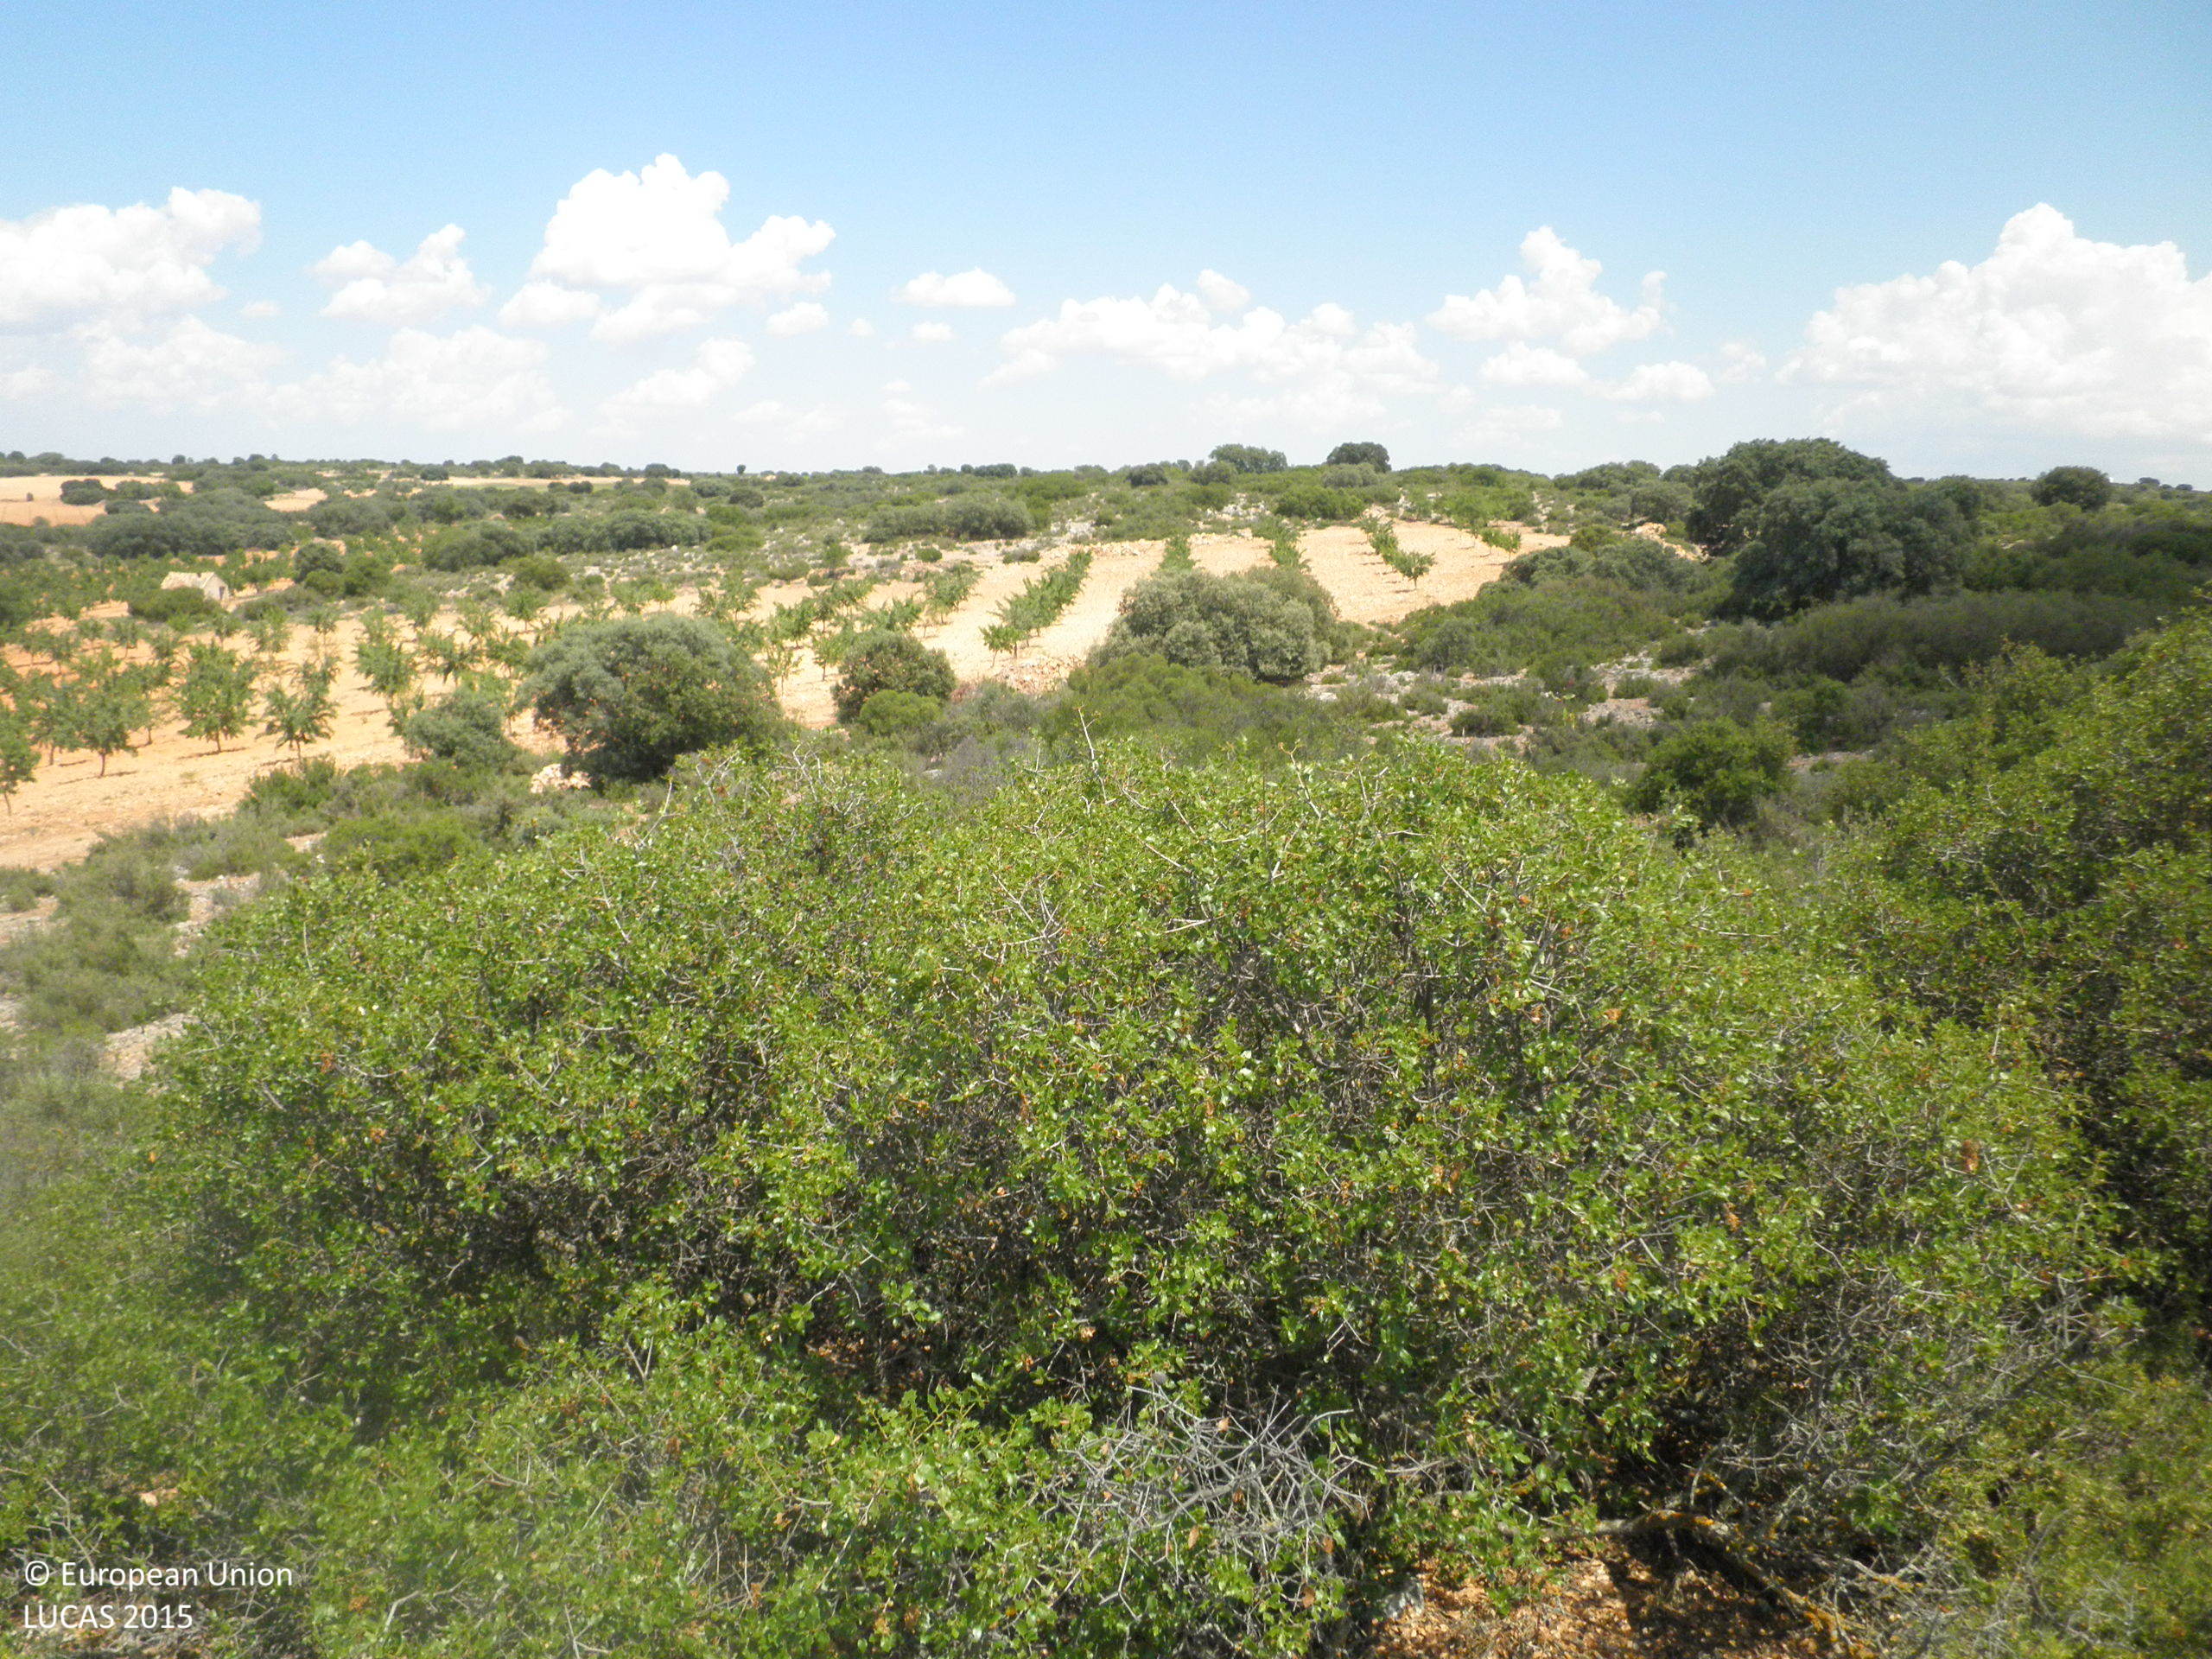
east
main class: Shrubland
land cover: Shrubland without tree cover
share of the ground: 25 - 50 %
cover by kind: consolidated bare surface 50 %, shrubs 40 %, unconsolidated bare surface 10 %
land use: Semi-natural and natural areas not in use
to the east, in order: Shrubland without tree cover; Dry stone walls; Grass margins; Tracks; Grass margins; Nuts trees; Dry stone walls; Grass margins; Tracks; Shrubland with sparse tree cover; Shrubland without tree cover; Broadleaved woodland
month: June
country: ES
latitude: 39.4844
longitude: -1.7599
